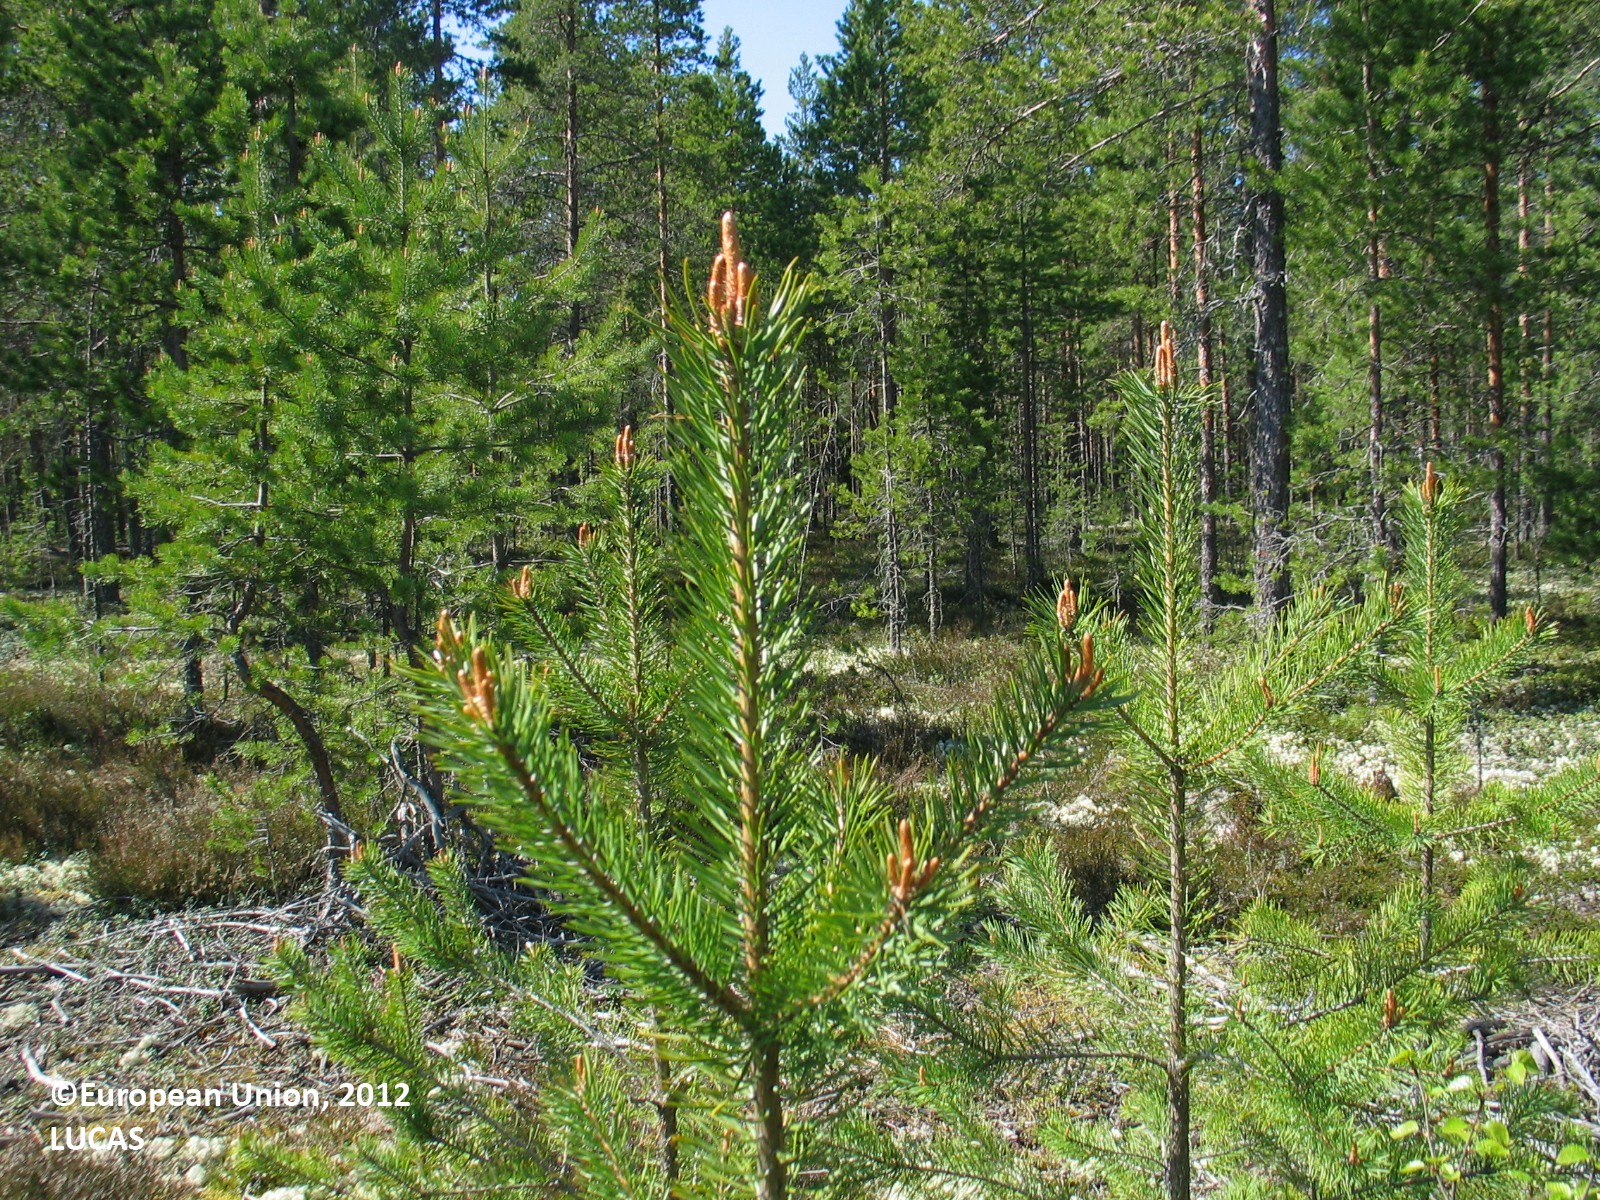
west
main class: Woodland
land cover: Pine dominated coniferous woodland
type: boreal forest
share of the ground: 25 - 50 %
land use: Forestry
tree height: < 5 m
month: May
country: FI
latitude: 64.9440
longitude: 25.2958
